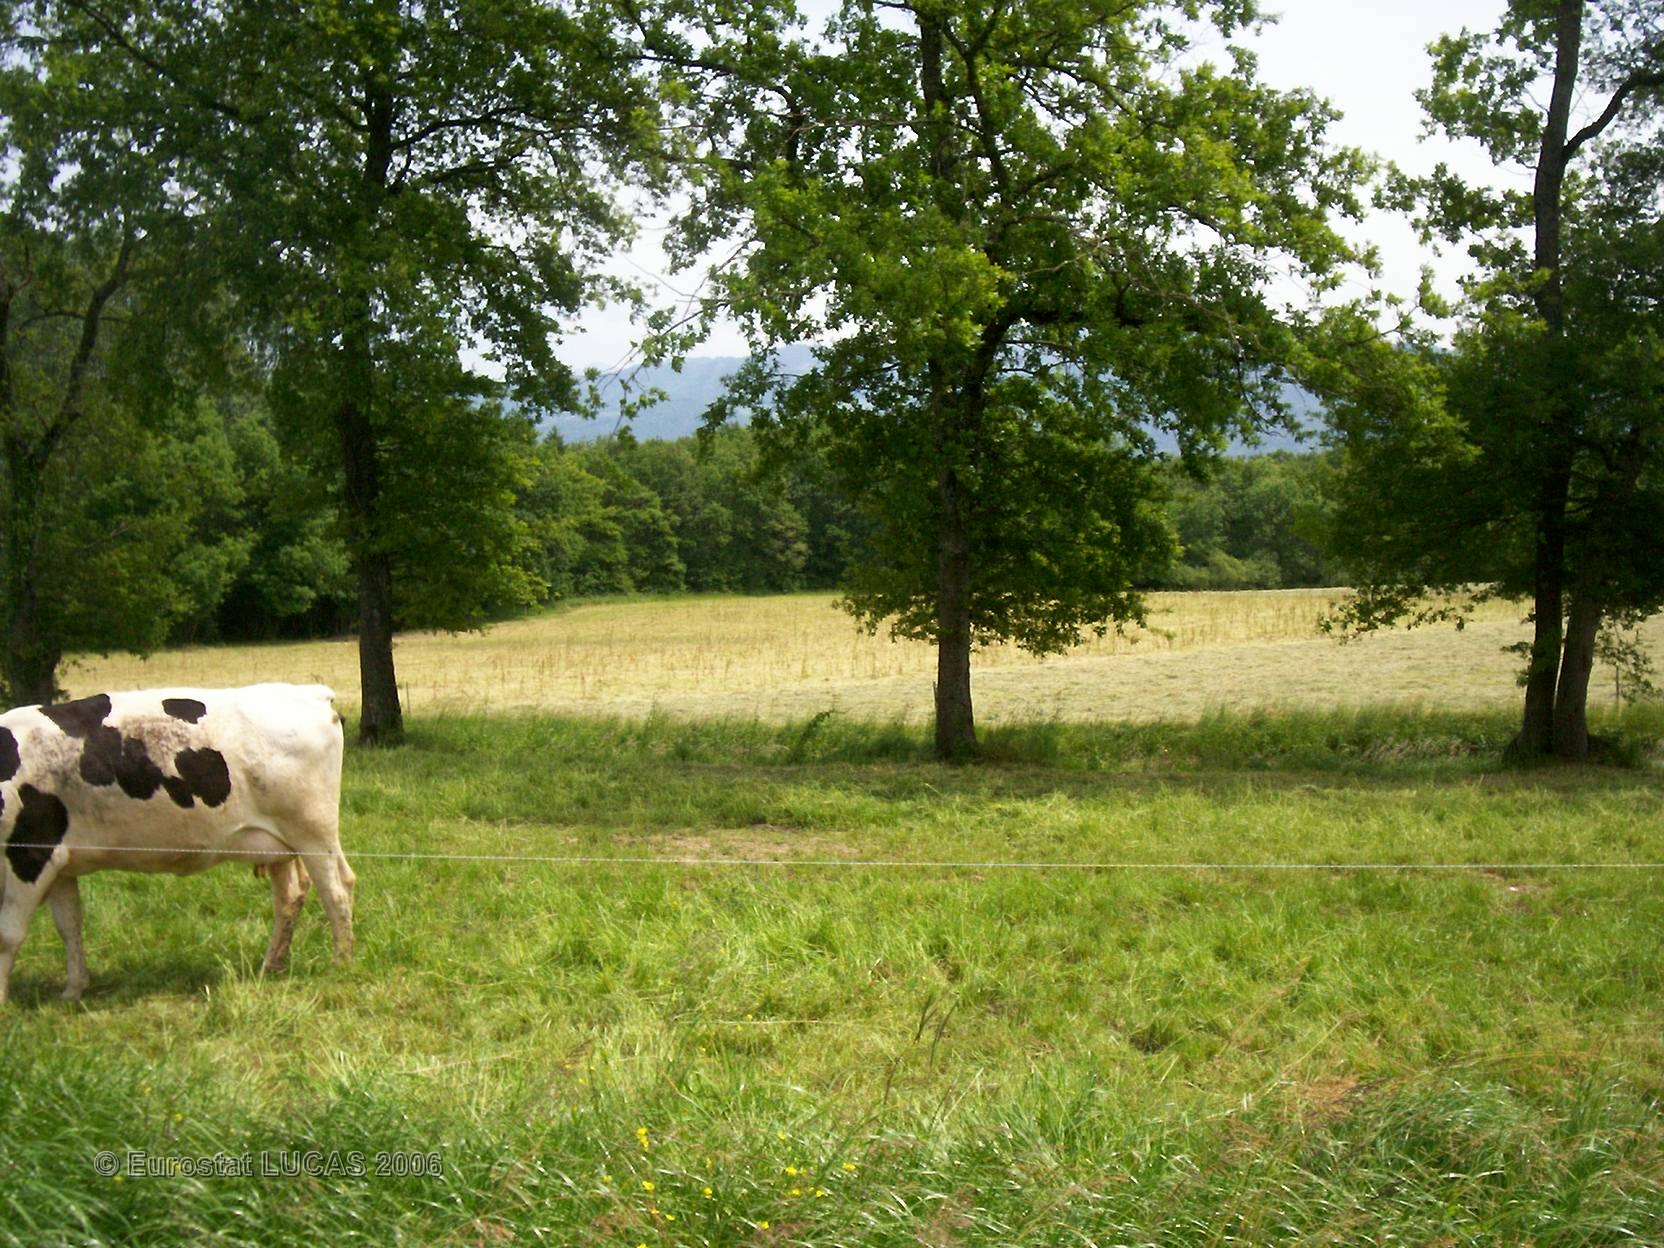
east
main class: Grassland
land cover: Grassland without tree/shrub cover
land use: Agriculture (excluding fallow land and kitchen gardens)
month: June
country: FR
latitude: 46.3080
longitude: 6.3806
